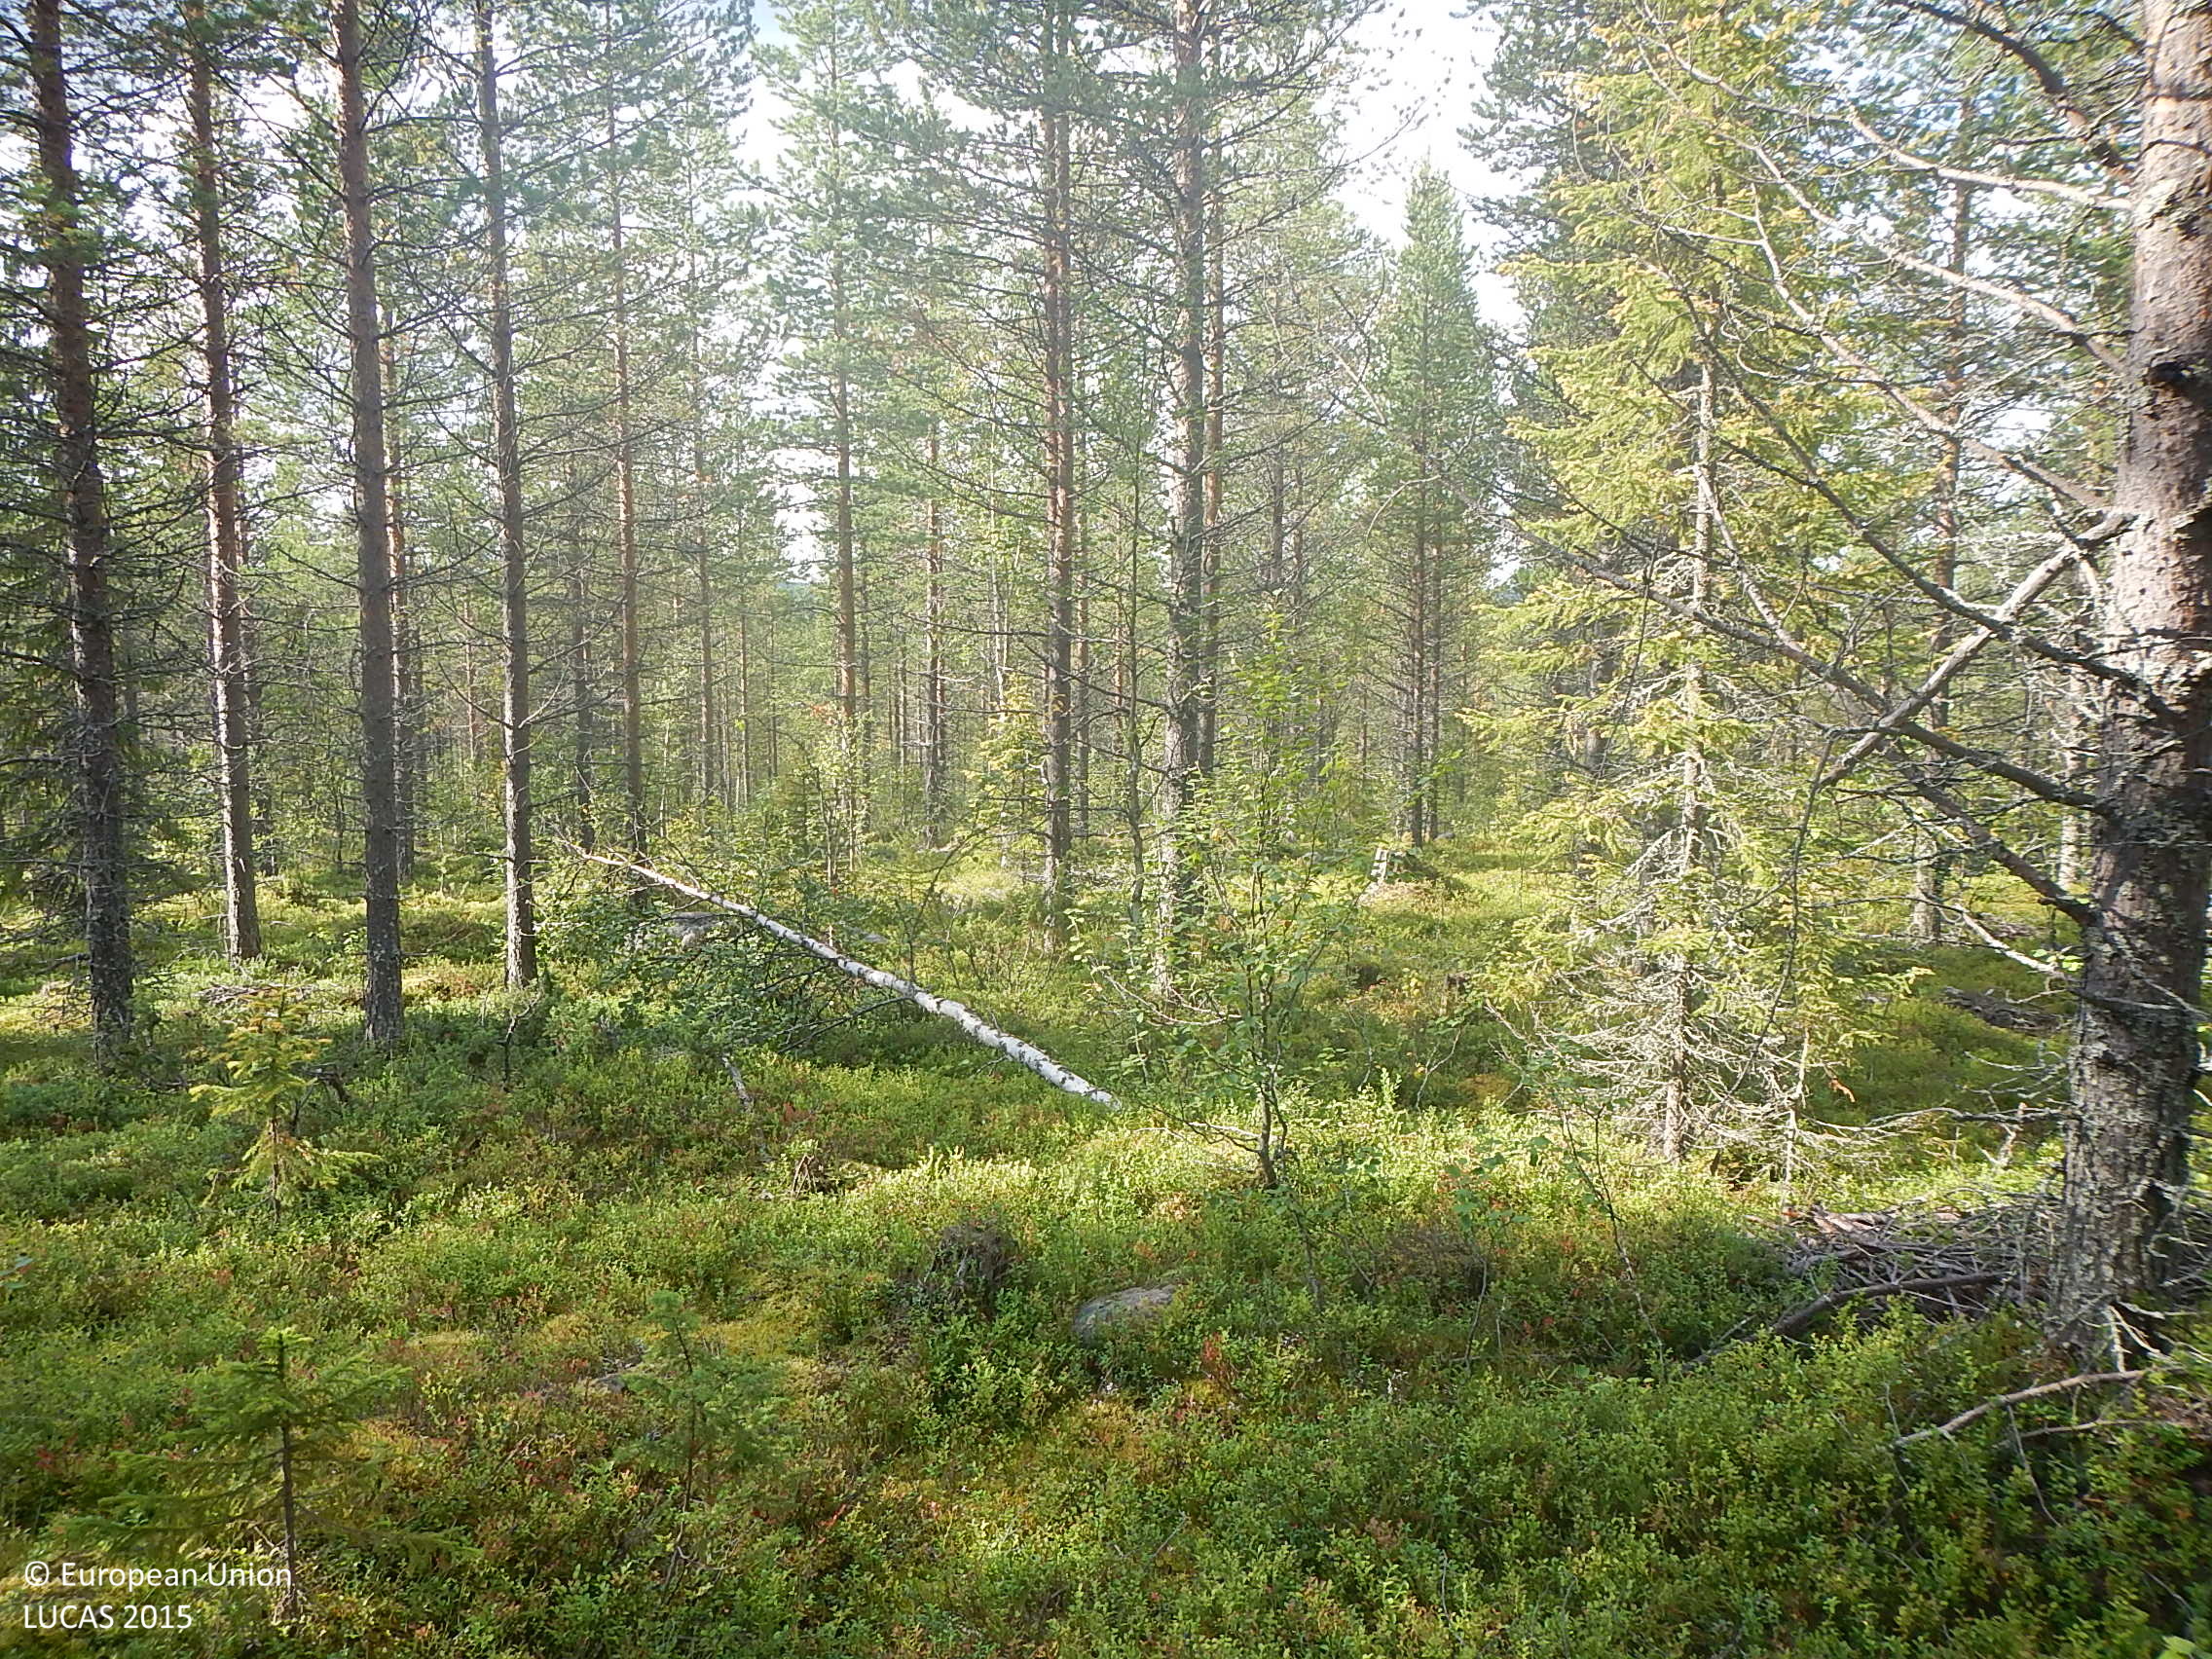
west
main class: Woodland
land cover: Pine dominated coniferous woodland
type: boreal forest
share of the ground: > 75 %
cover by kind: coniferous forest trees 75 %, shrubs 20 %, lichens and mosses 5 %
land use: Forestry
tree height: > 5 m
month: August
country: FI
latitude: 66.1199
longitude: 27.4522
